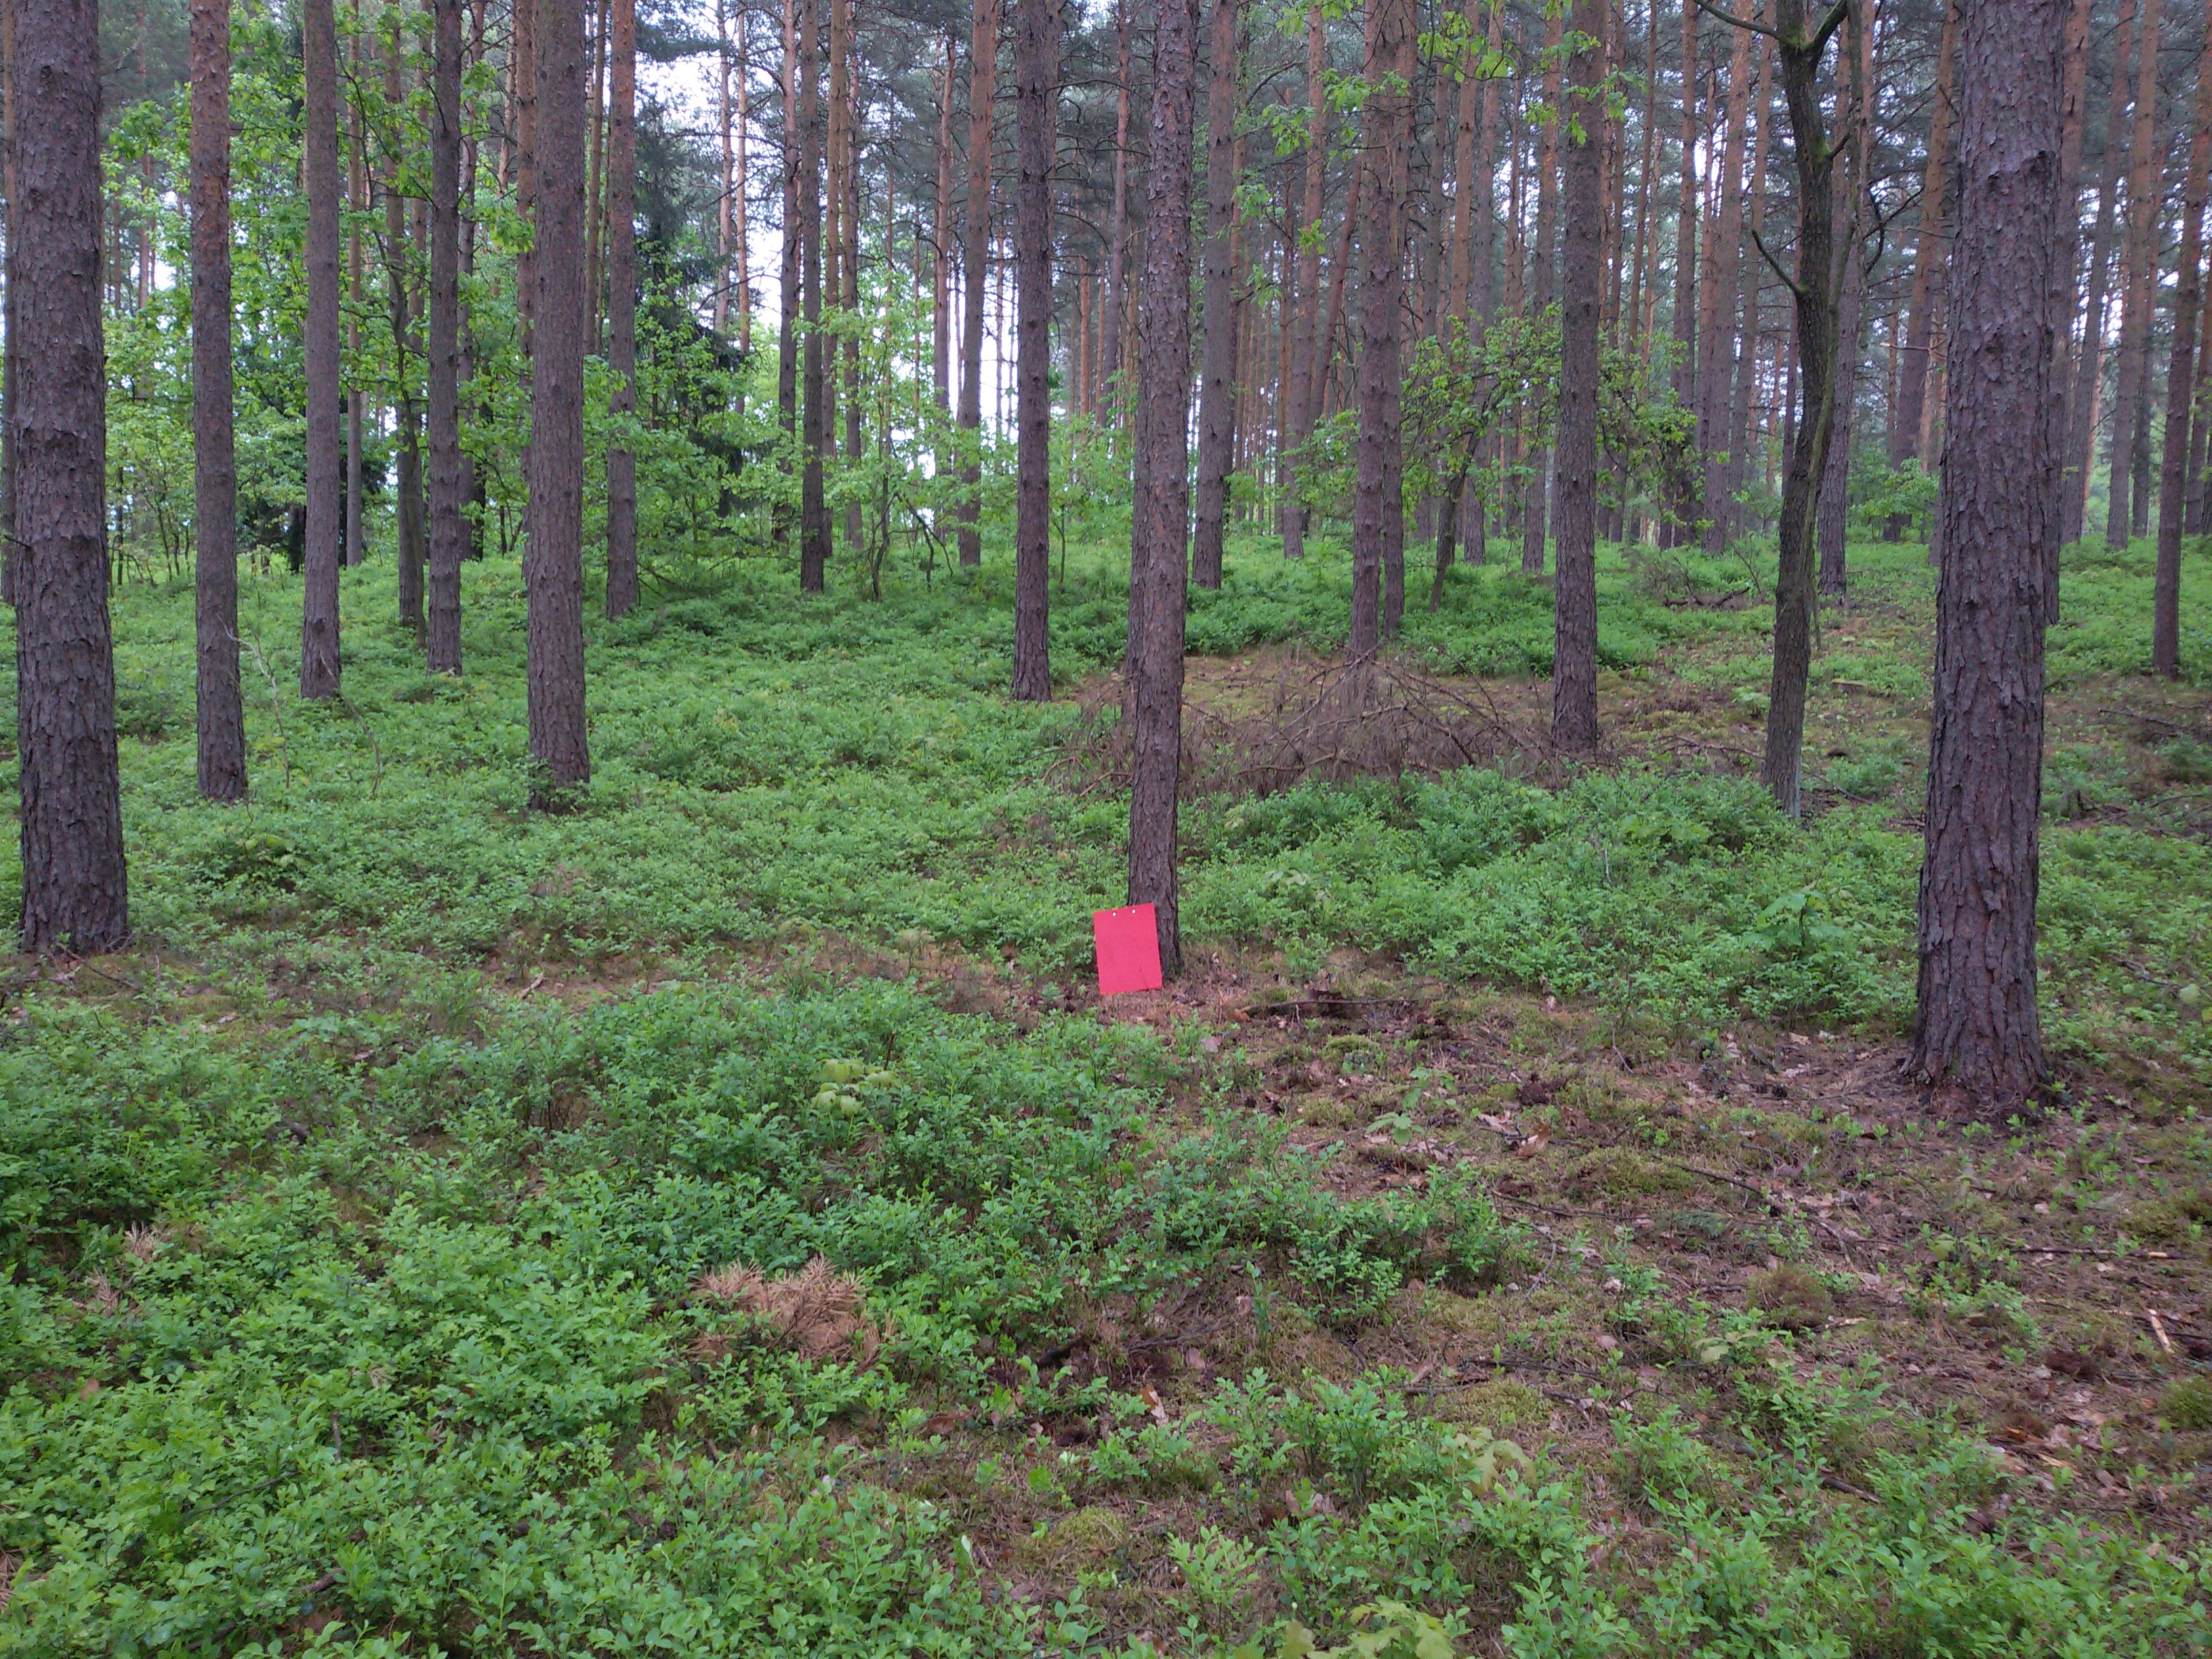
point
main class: Woodland
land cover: Pine dominated coniferous woodland
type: hemiboreal forest and nemoral coniferous forest and mixed broadleaved-coniferous forest
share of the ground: > 75 %
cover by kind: coniferous forest trees 90 %, lichens and mosses 10 %
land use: Forestry
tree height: > 5 m
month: May
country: PL
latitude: 51.3558
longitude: 15.7347
